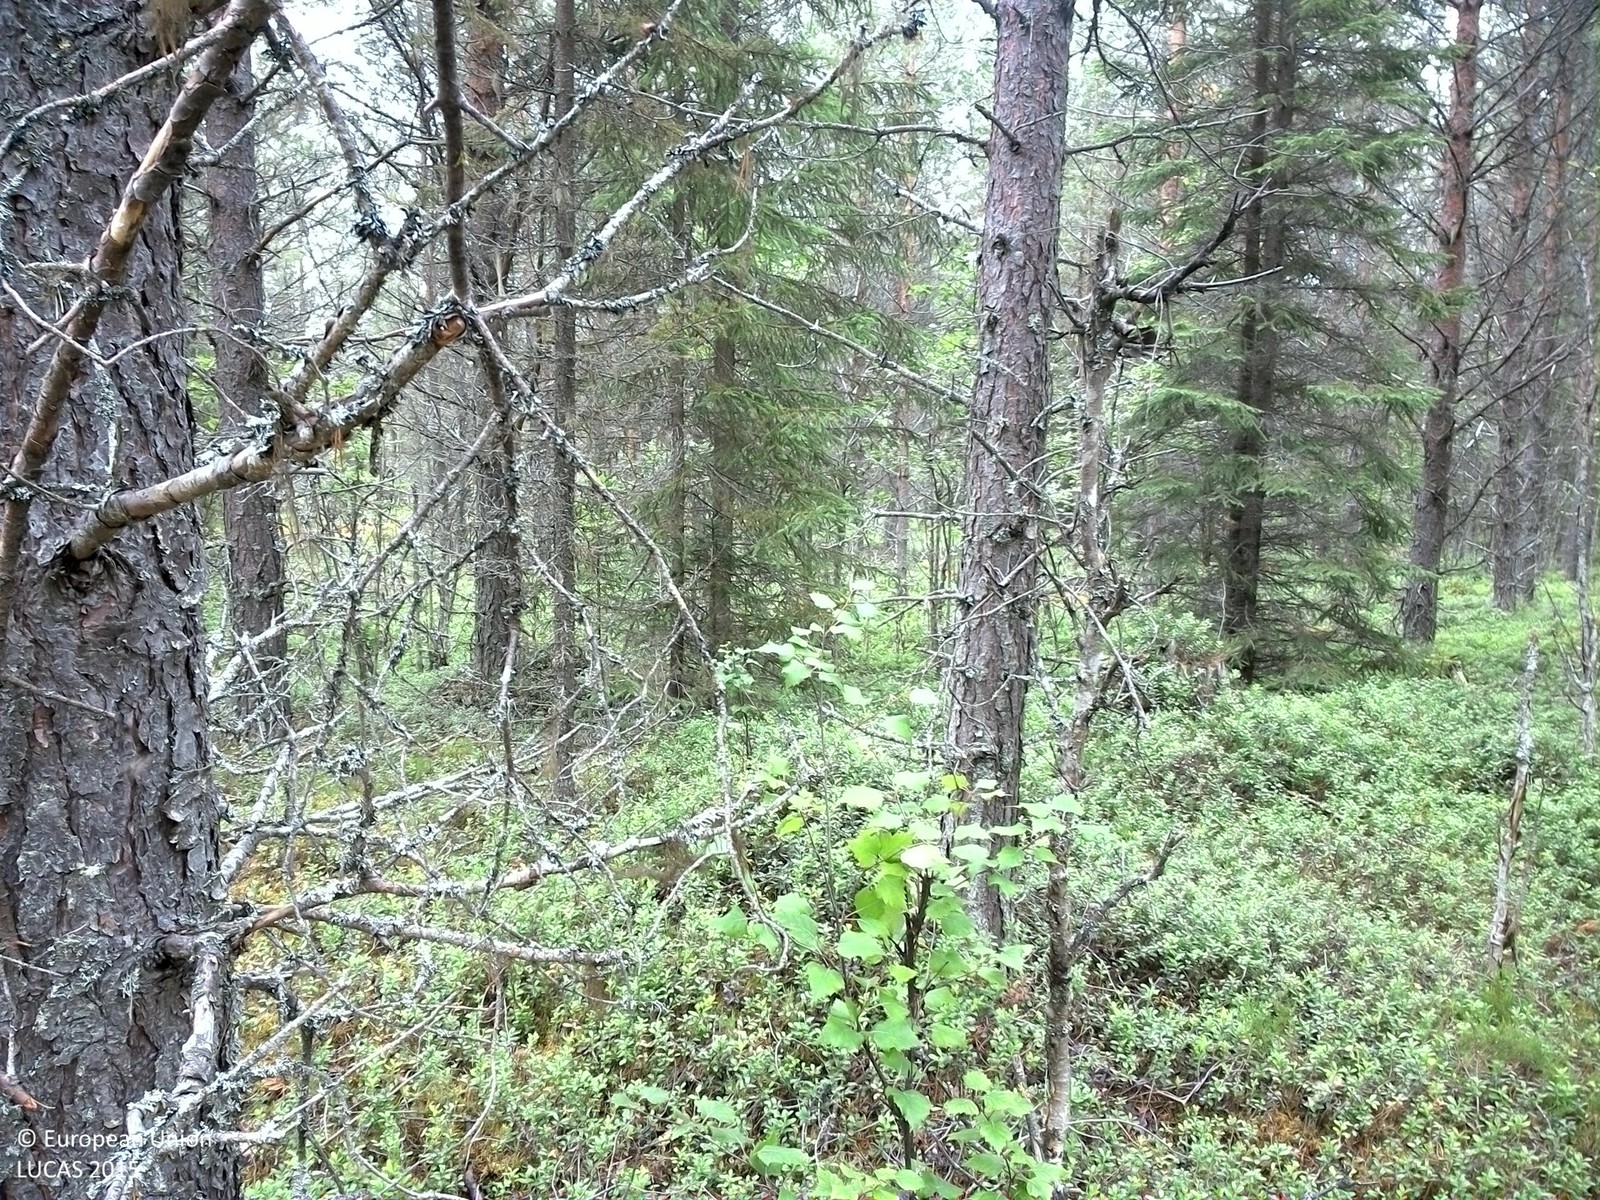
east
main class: Woodland
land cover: Pine dominated coniferous woodland
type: boreal forest
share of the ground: 50 - 75 %
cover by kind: coniferous forest trees 50 %, shrubs 30 %, lichens and mosses 15 %, broadleaved forest trees 5 %
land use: Forestry
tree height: > 5 m
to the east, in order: Pine dominated coniferous woodland; Pine dominated mixed woodland
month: July
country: SE
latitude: 63.6050
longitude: 17.0902
